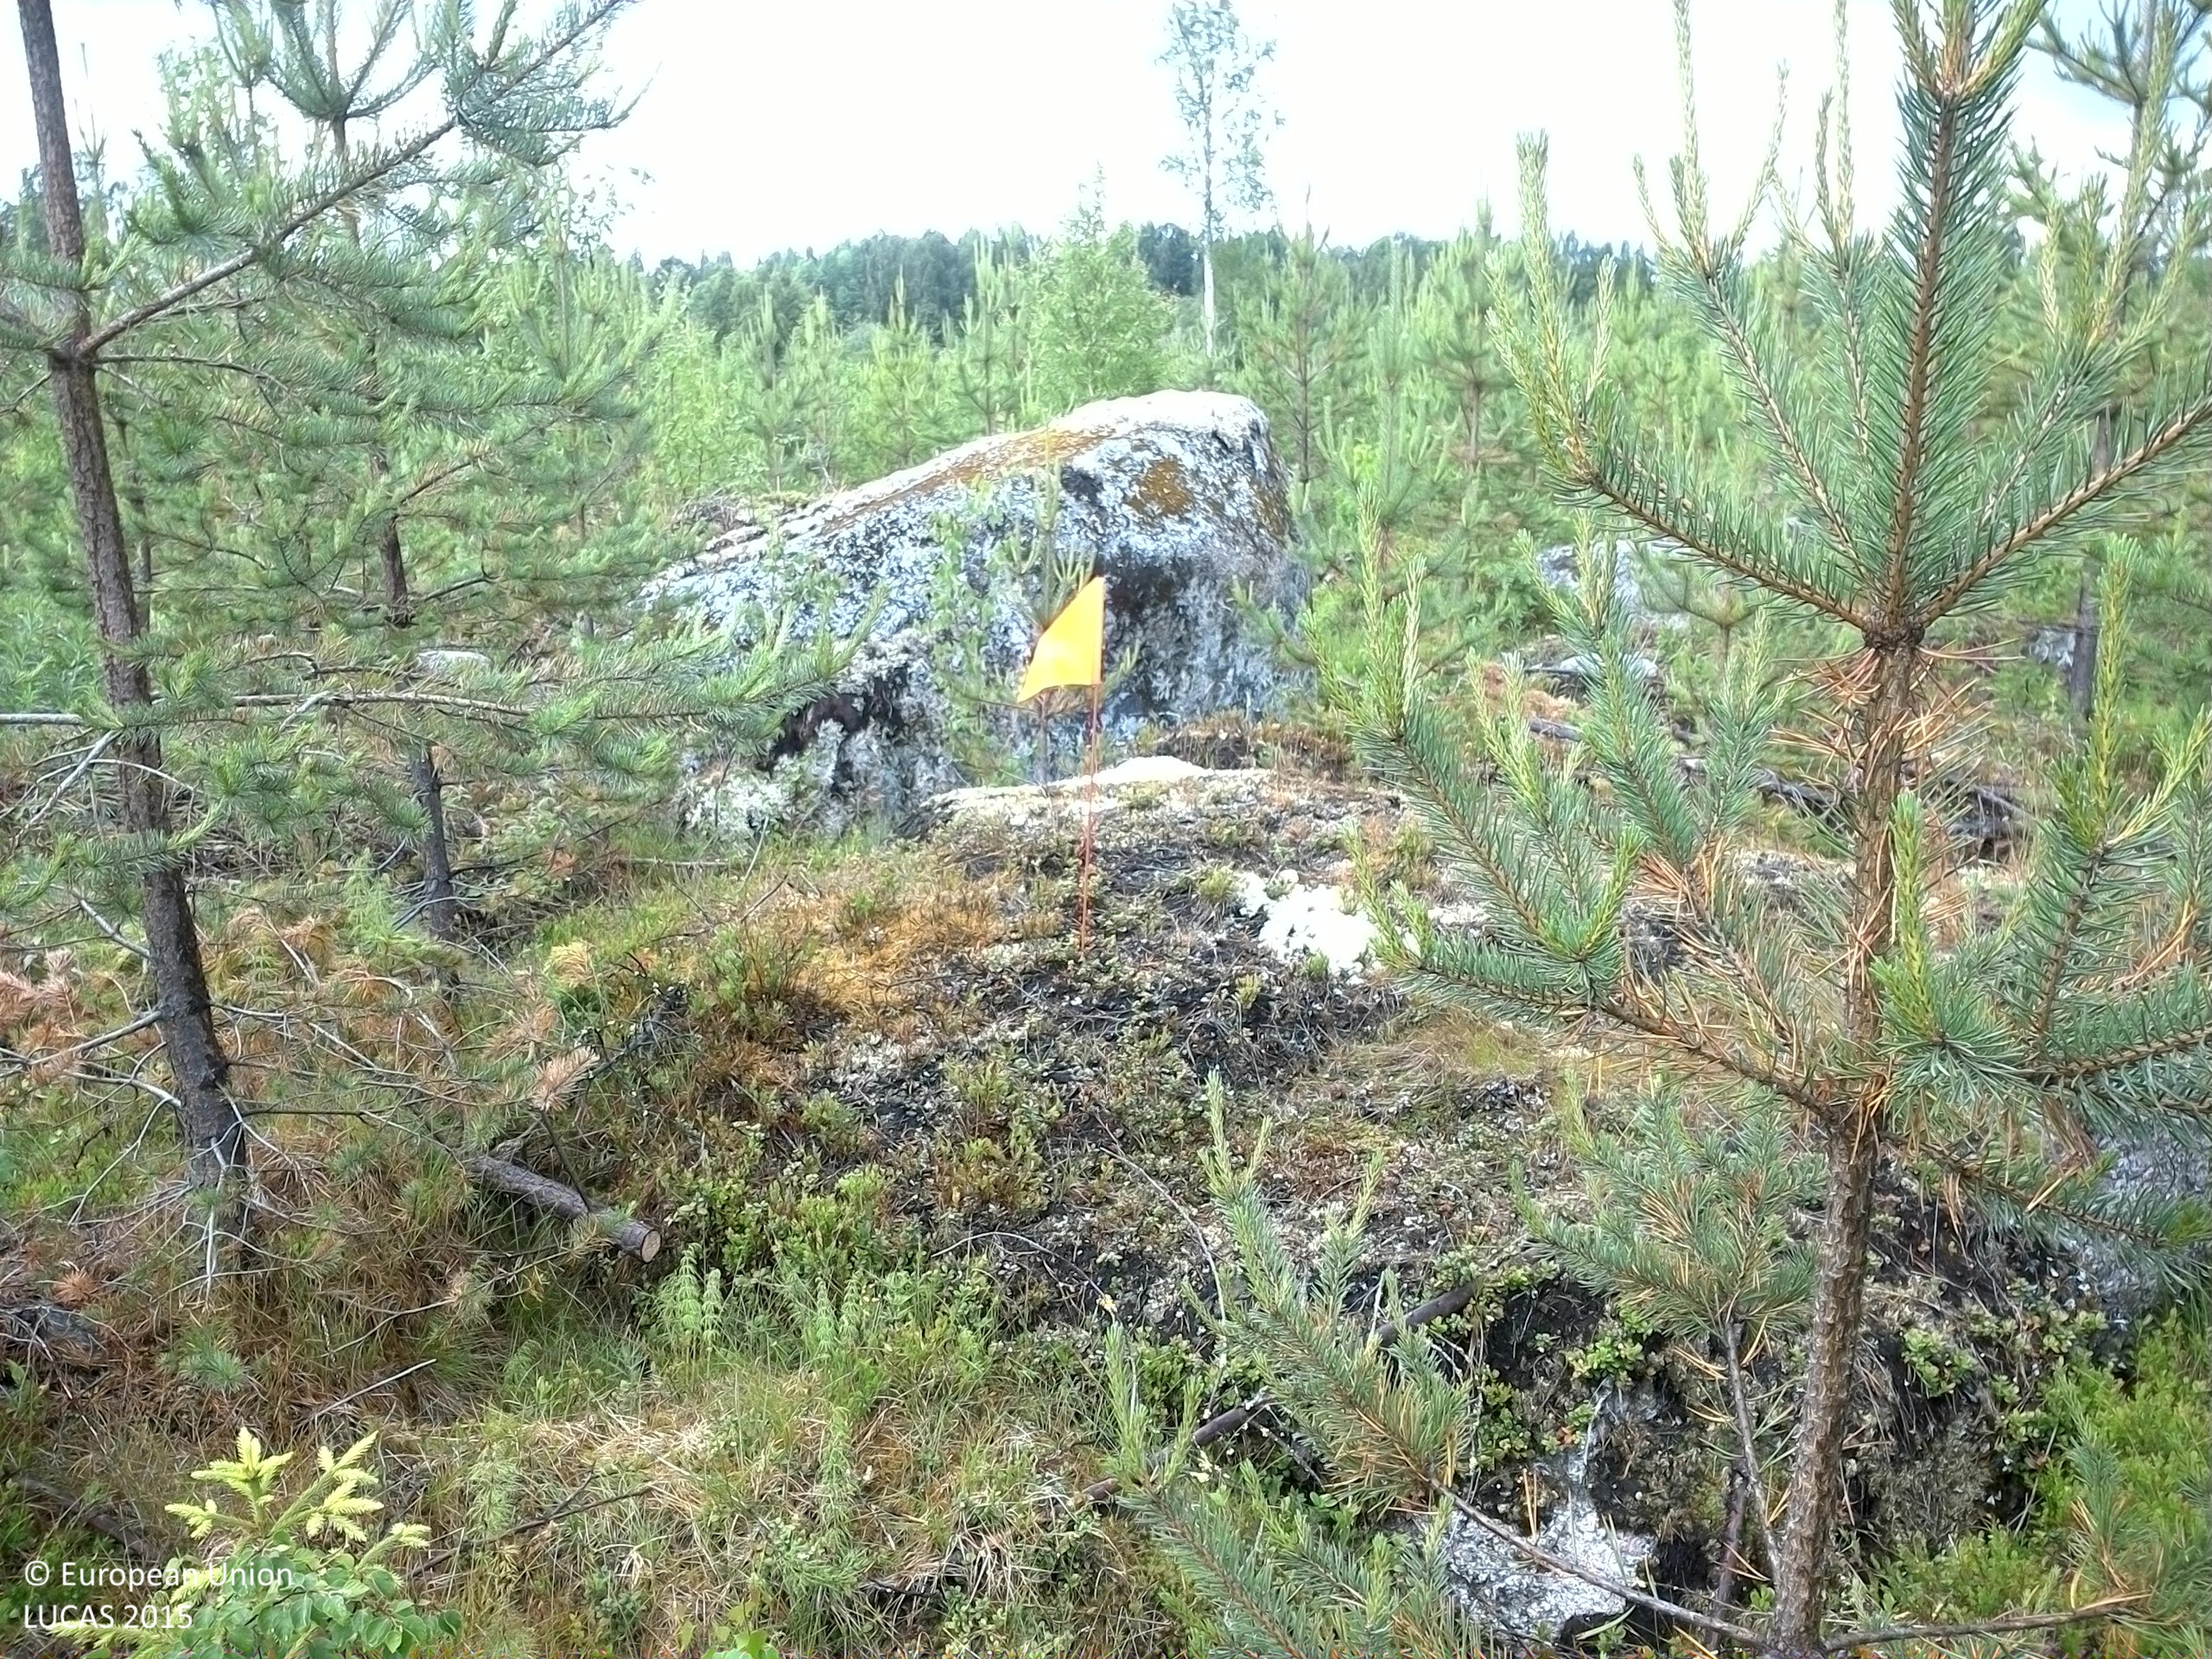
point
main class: Woodland
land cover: Pine dominated coniferous woodland
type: boreal forest
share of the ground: 25 - 50 %
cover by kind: coniferous forest trees 40 %, shrubs 20 %, herbaceous plants 20 %, lichens and mosses 15 %, broadleaved forest trees 5 %
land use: Forestry
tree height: < 5 m
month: July
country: SE
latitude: 63.6156
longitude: 18.6686
